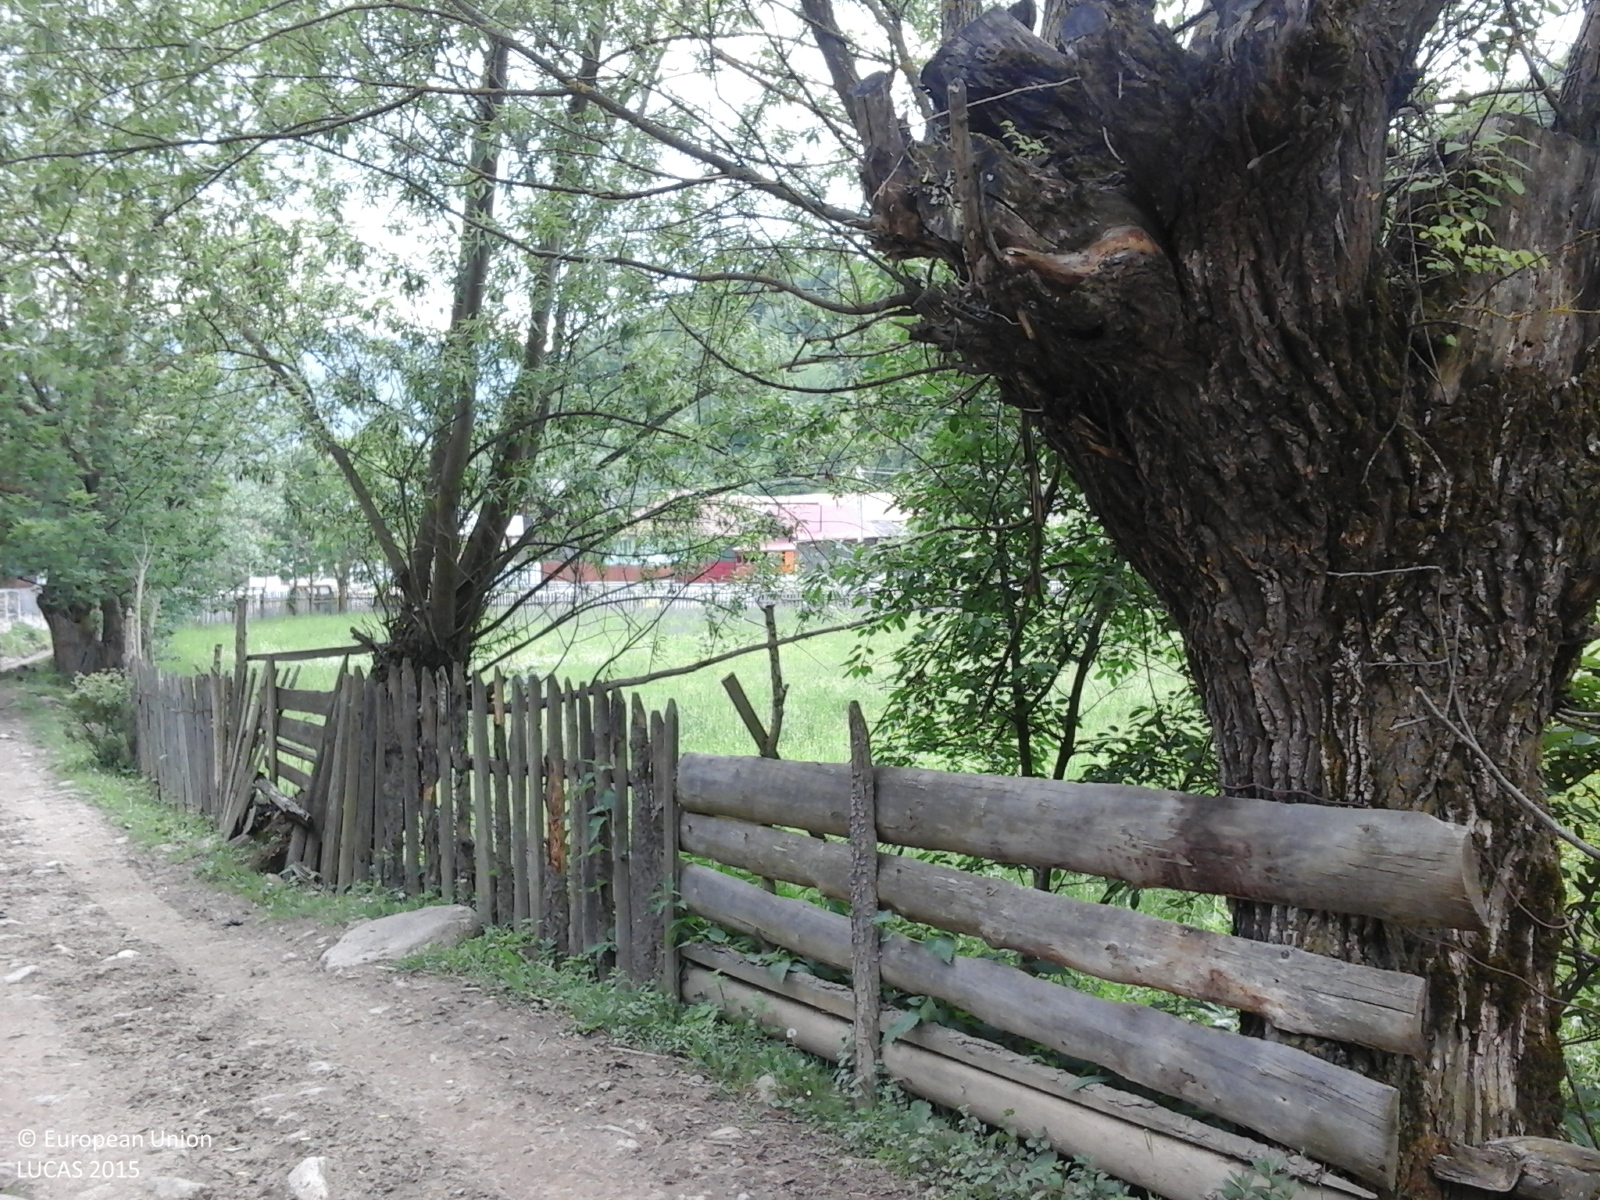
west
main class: Woodland
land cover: Spruce dominated coniferous woodland
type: alpine coniferous forest
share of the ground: > 75 %
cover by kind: coniferous forest trees 90 %, broadleaved forest trees 10 %
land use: Forestry
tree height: > 5 m
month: June
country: RO
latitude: 46.5370
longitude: 26.2038
